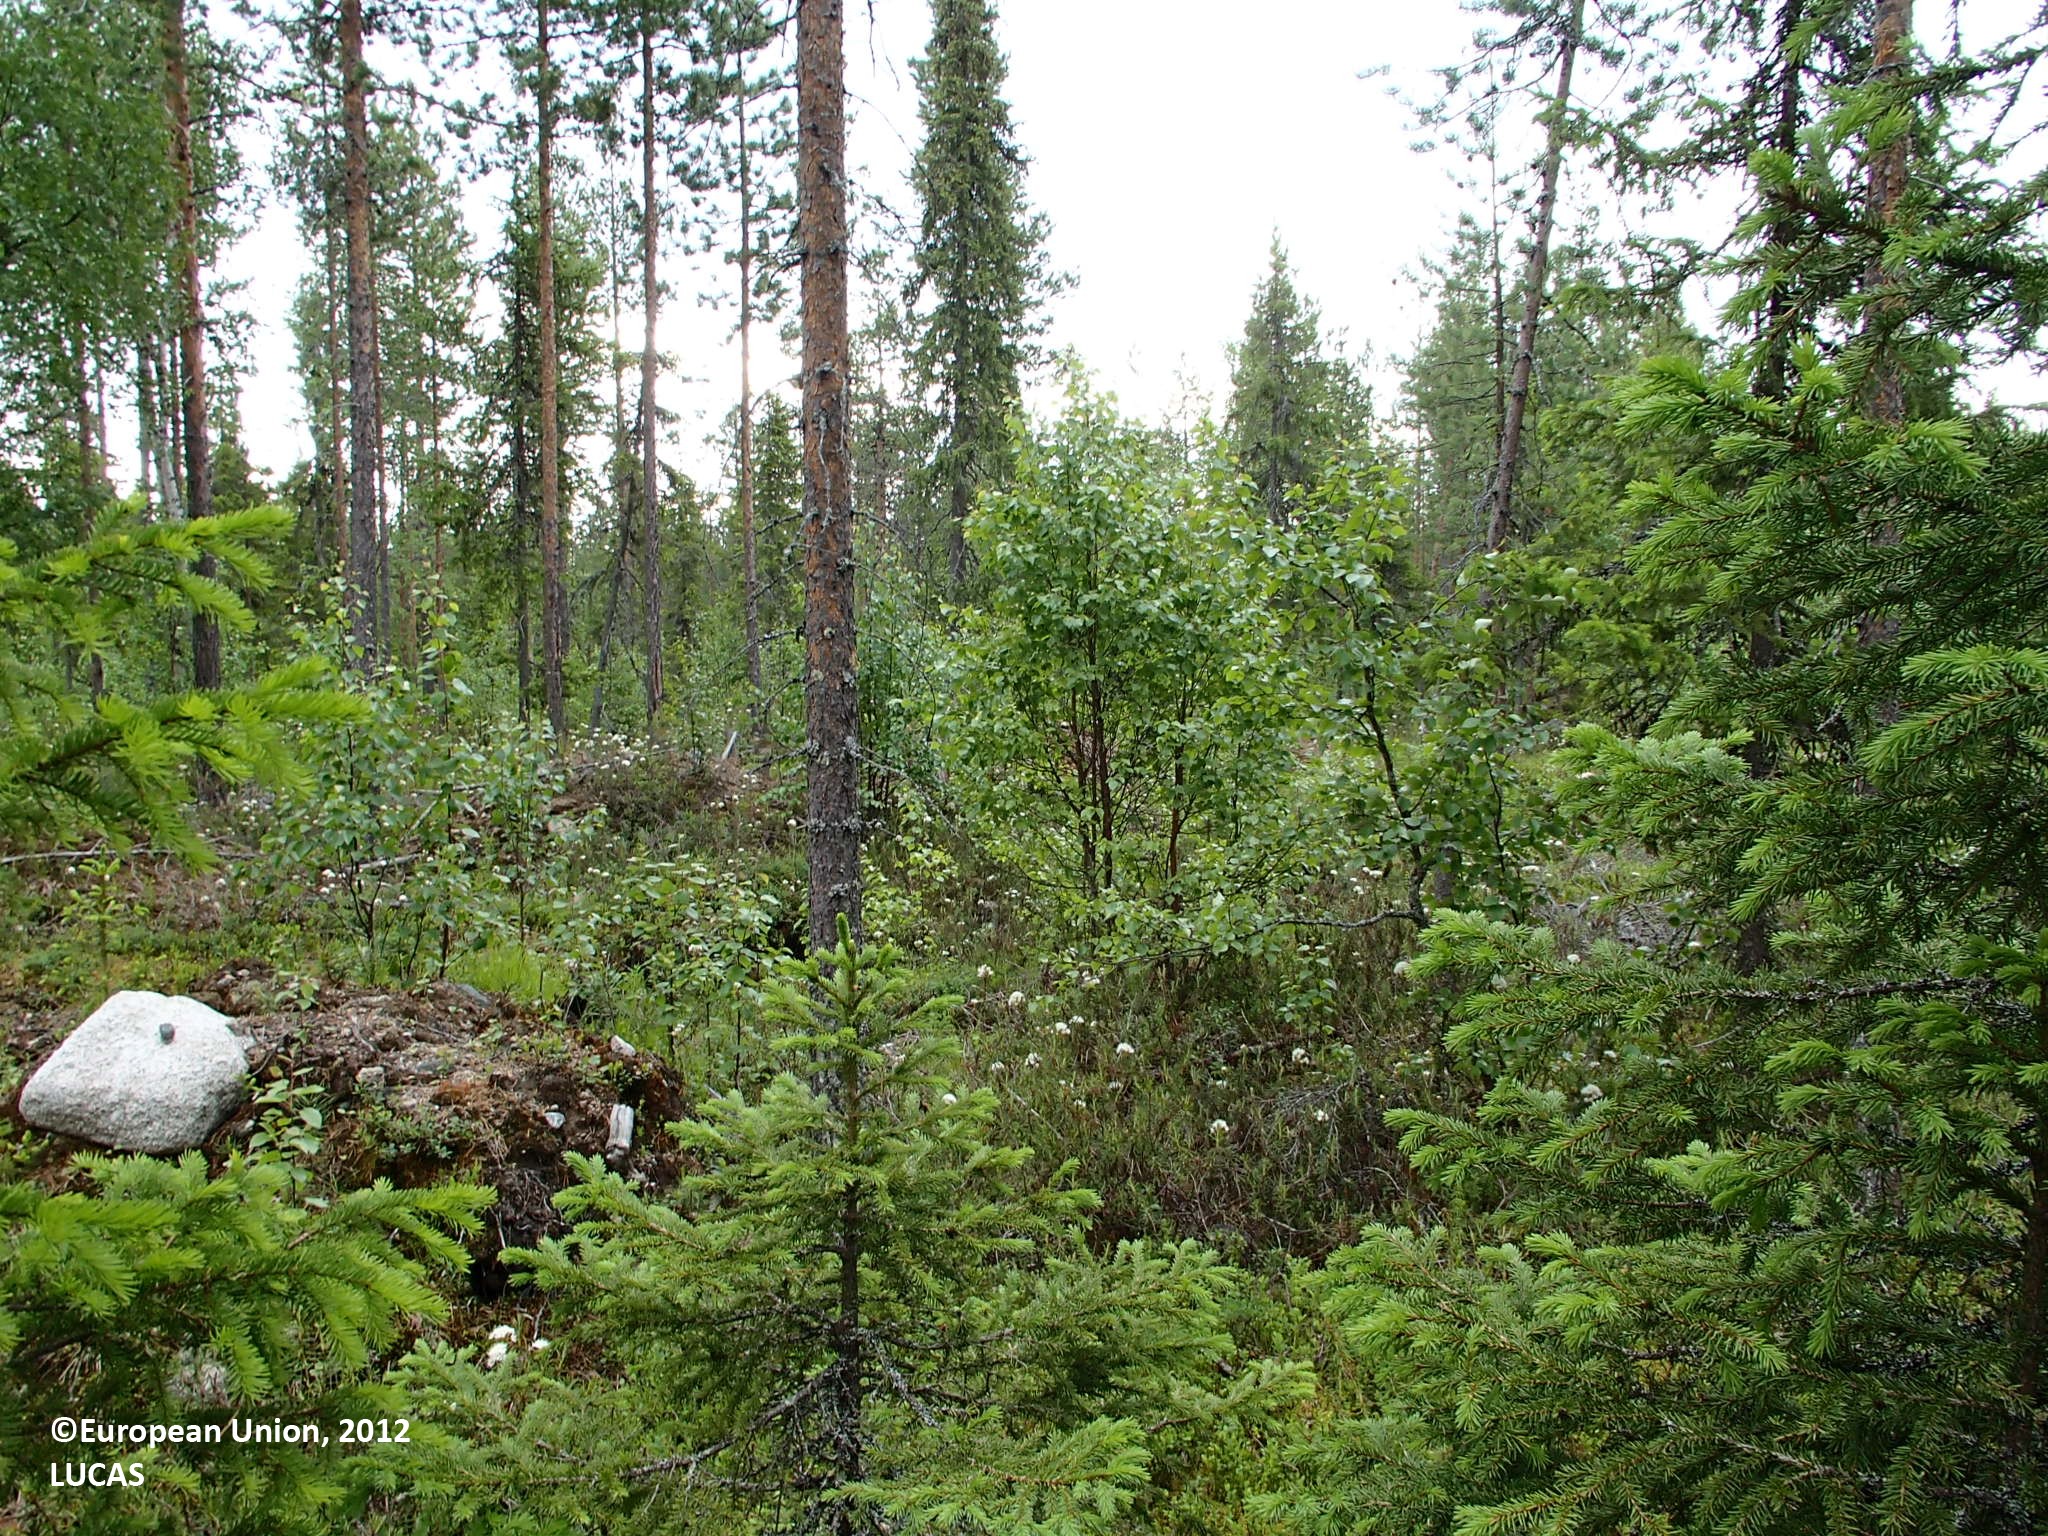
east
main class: Woodland
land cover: Other coniferous woodland
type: boreal forest
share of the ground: > 75 %
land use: Forestry
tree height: > 5 m
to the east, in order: Other coniferous woodland; Spruce dominated coniferous woodland; Ditches and canals; Pine dominated coniferous woodland; Ditches and canals; Spruce dominated coniferous woodland; Ditches and canals; Pine dominated coniferous woodland; Ditches and canals; Pine dominated mixed woodland; Ditches and canals; Pine dominated mixed woodland; Ditches and canals; Pine dominated mixed woodland; Ditches and canals
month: June
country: FI
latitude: 66.8740
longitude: 27.5648
